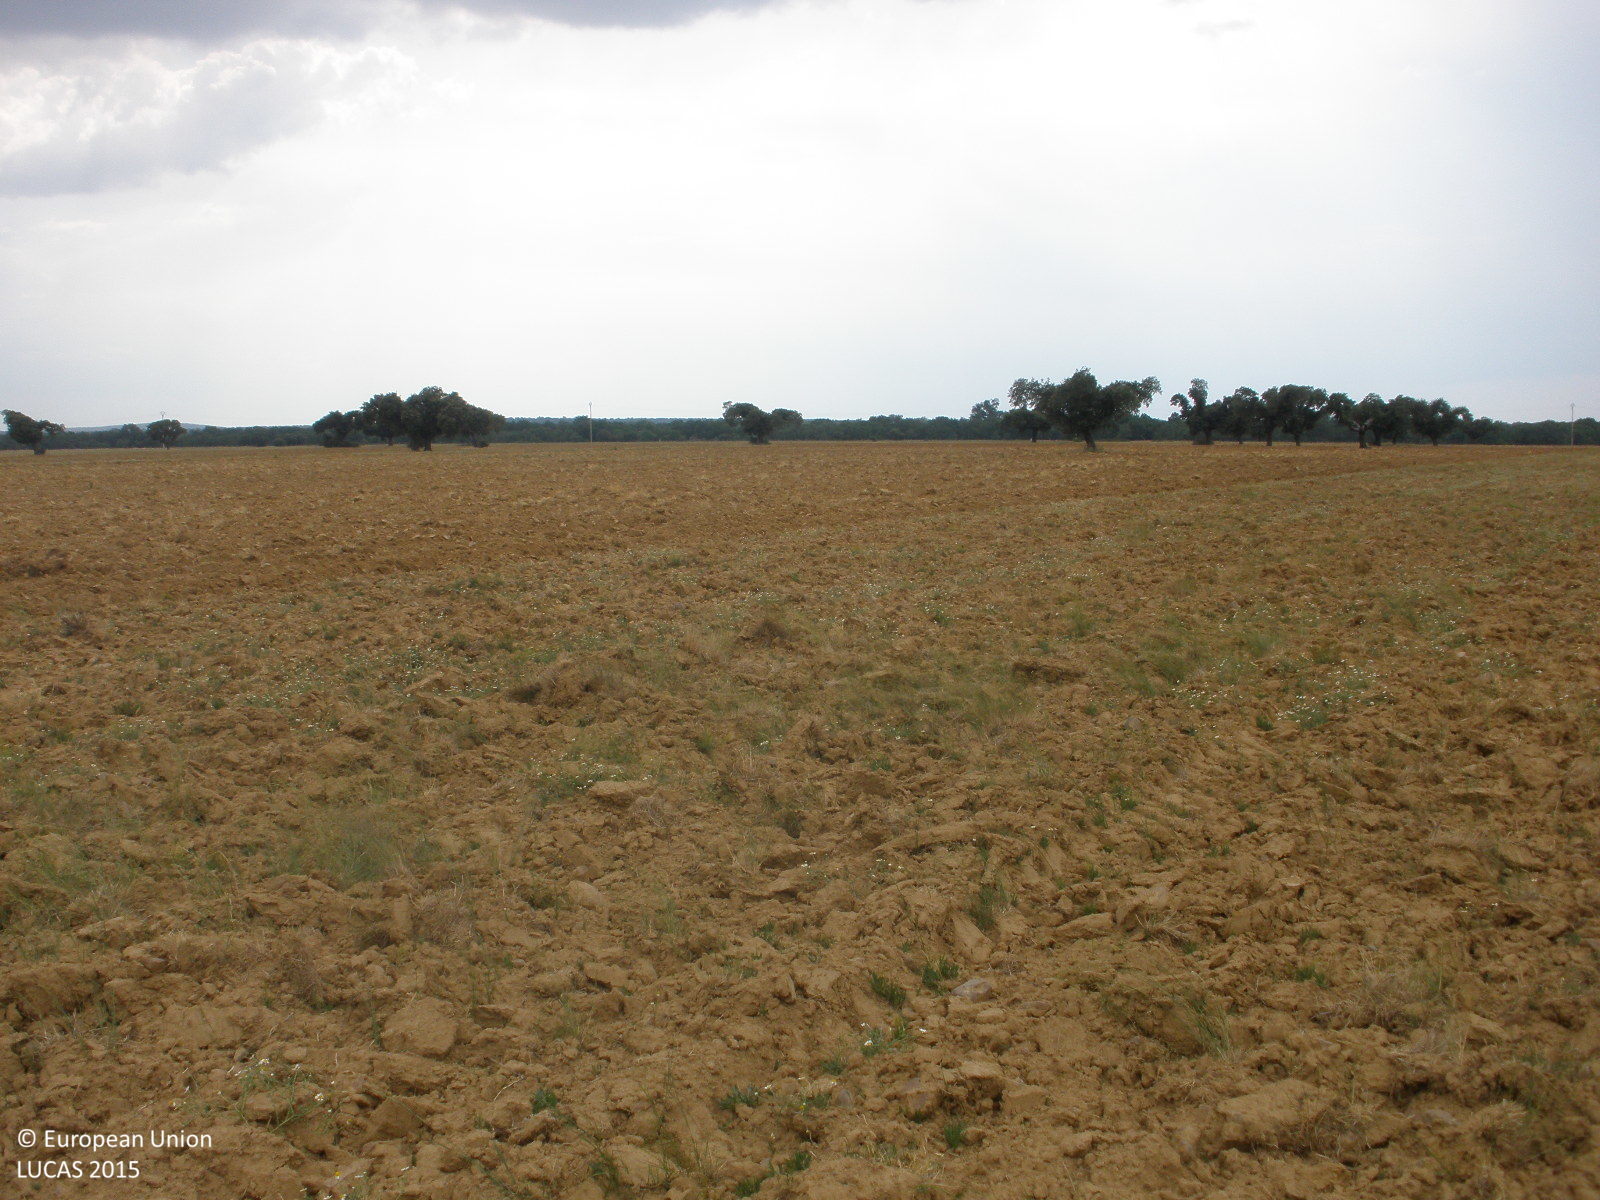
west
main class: Grassland
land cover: Spontaneously vegetated surfaces
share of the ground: 25 - 50 %
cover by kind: unconsolidated bare surface 60 %, herbaceous plants 40 %
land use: Fallow land
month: June
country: ES
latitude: 40.7371
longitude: -6.3948
